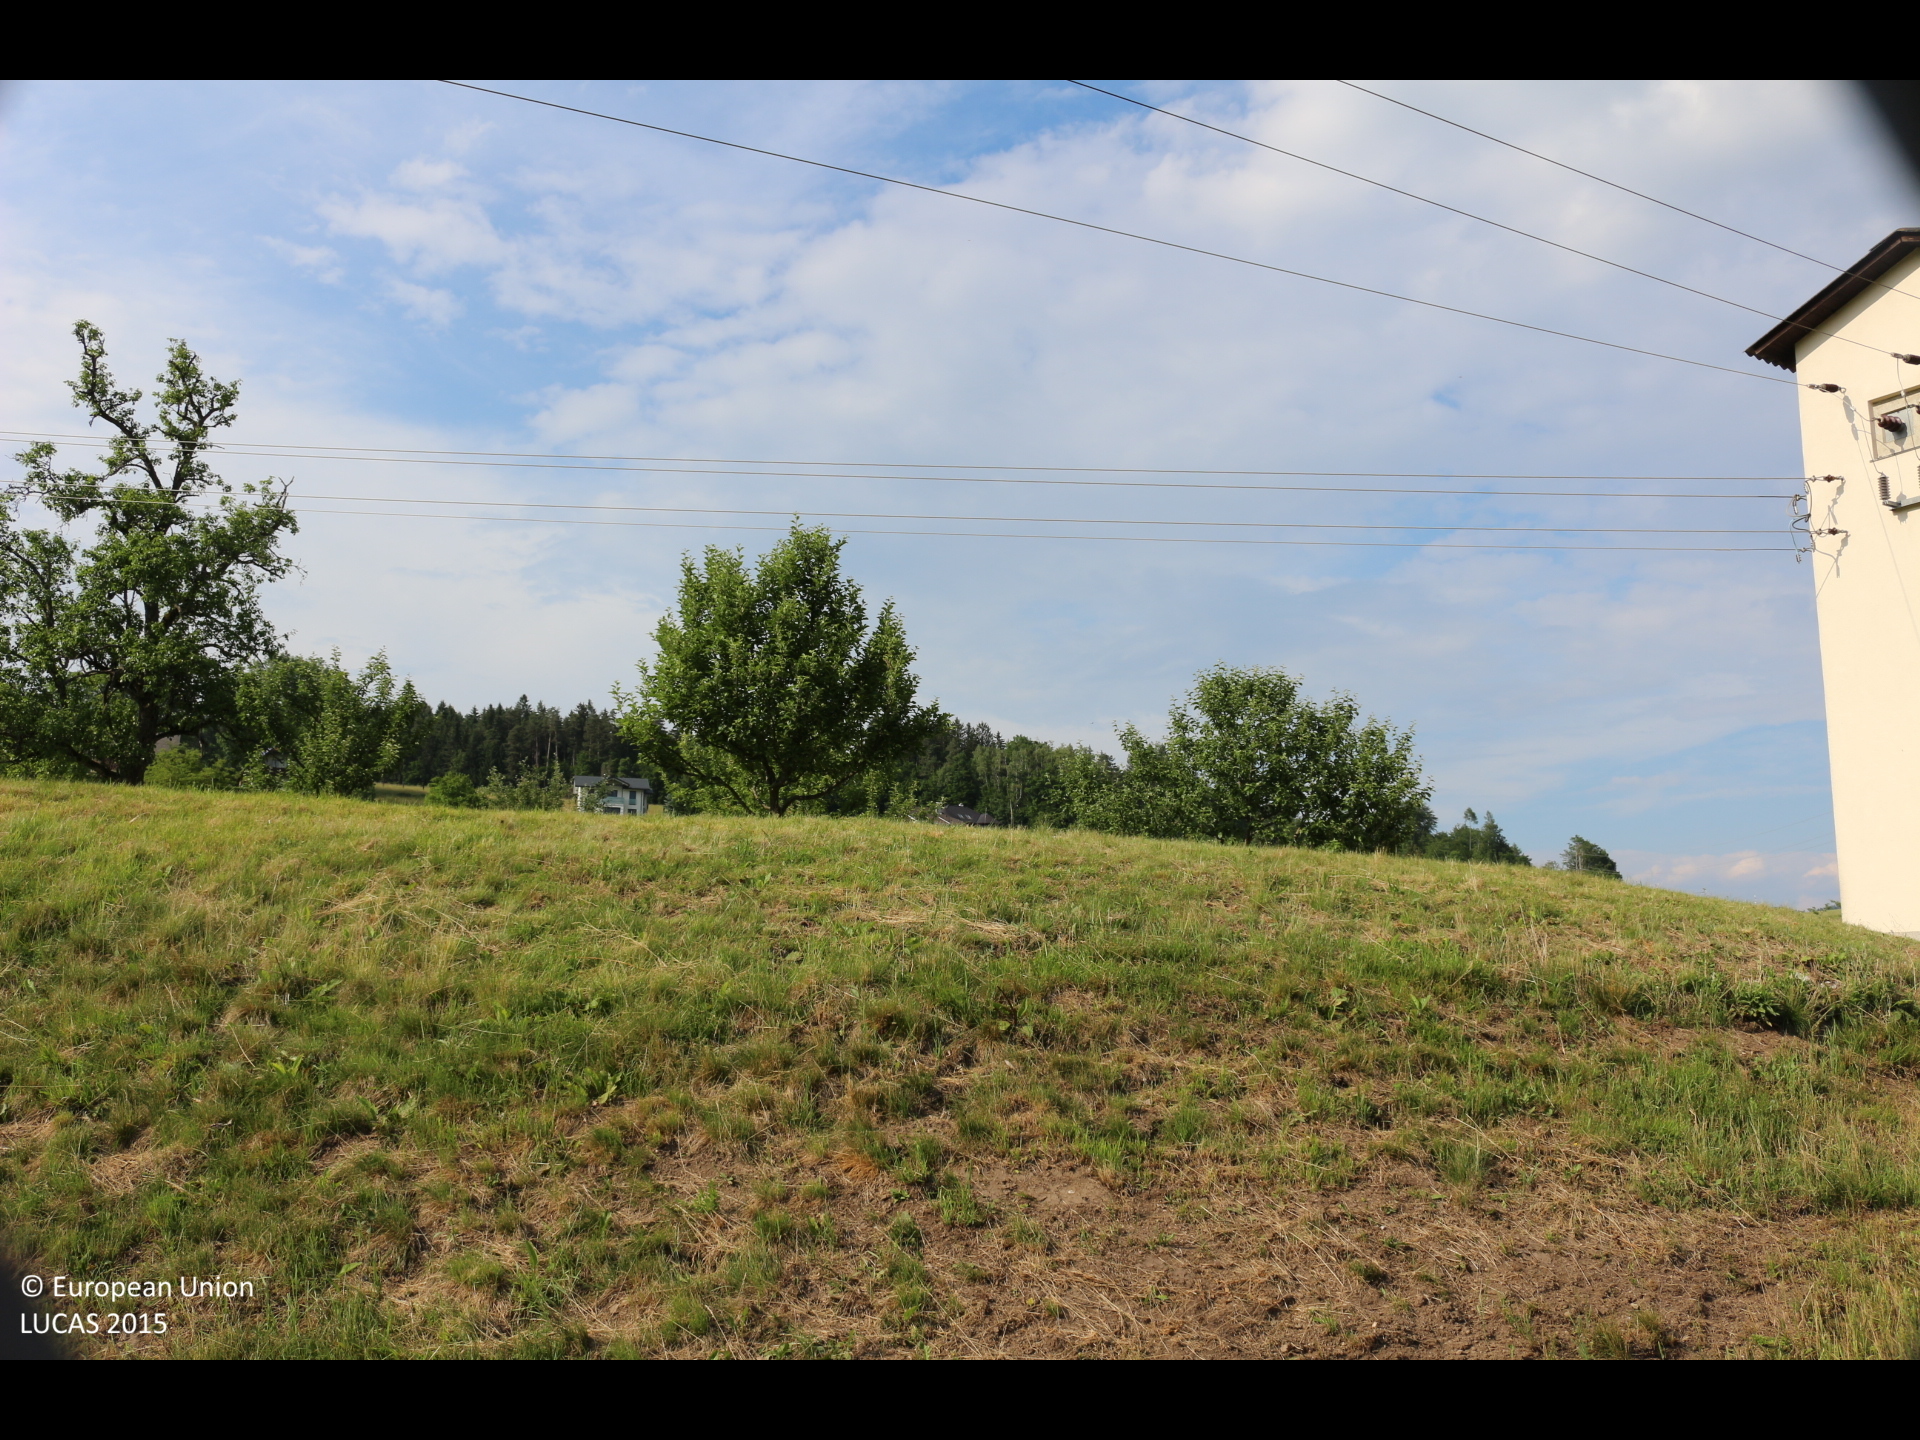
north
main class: Grassland
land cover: Grassland without tree/shrub cover
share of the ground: > 75 %
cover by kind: herbaceous plants 100 %
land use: Agriculture (excluding fallow land and kitchen gardens)
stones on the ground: < 10 %
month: June
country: AT
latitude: 46.5549
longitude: 14.2625
